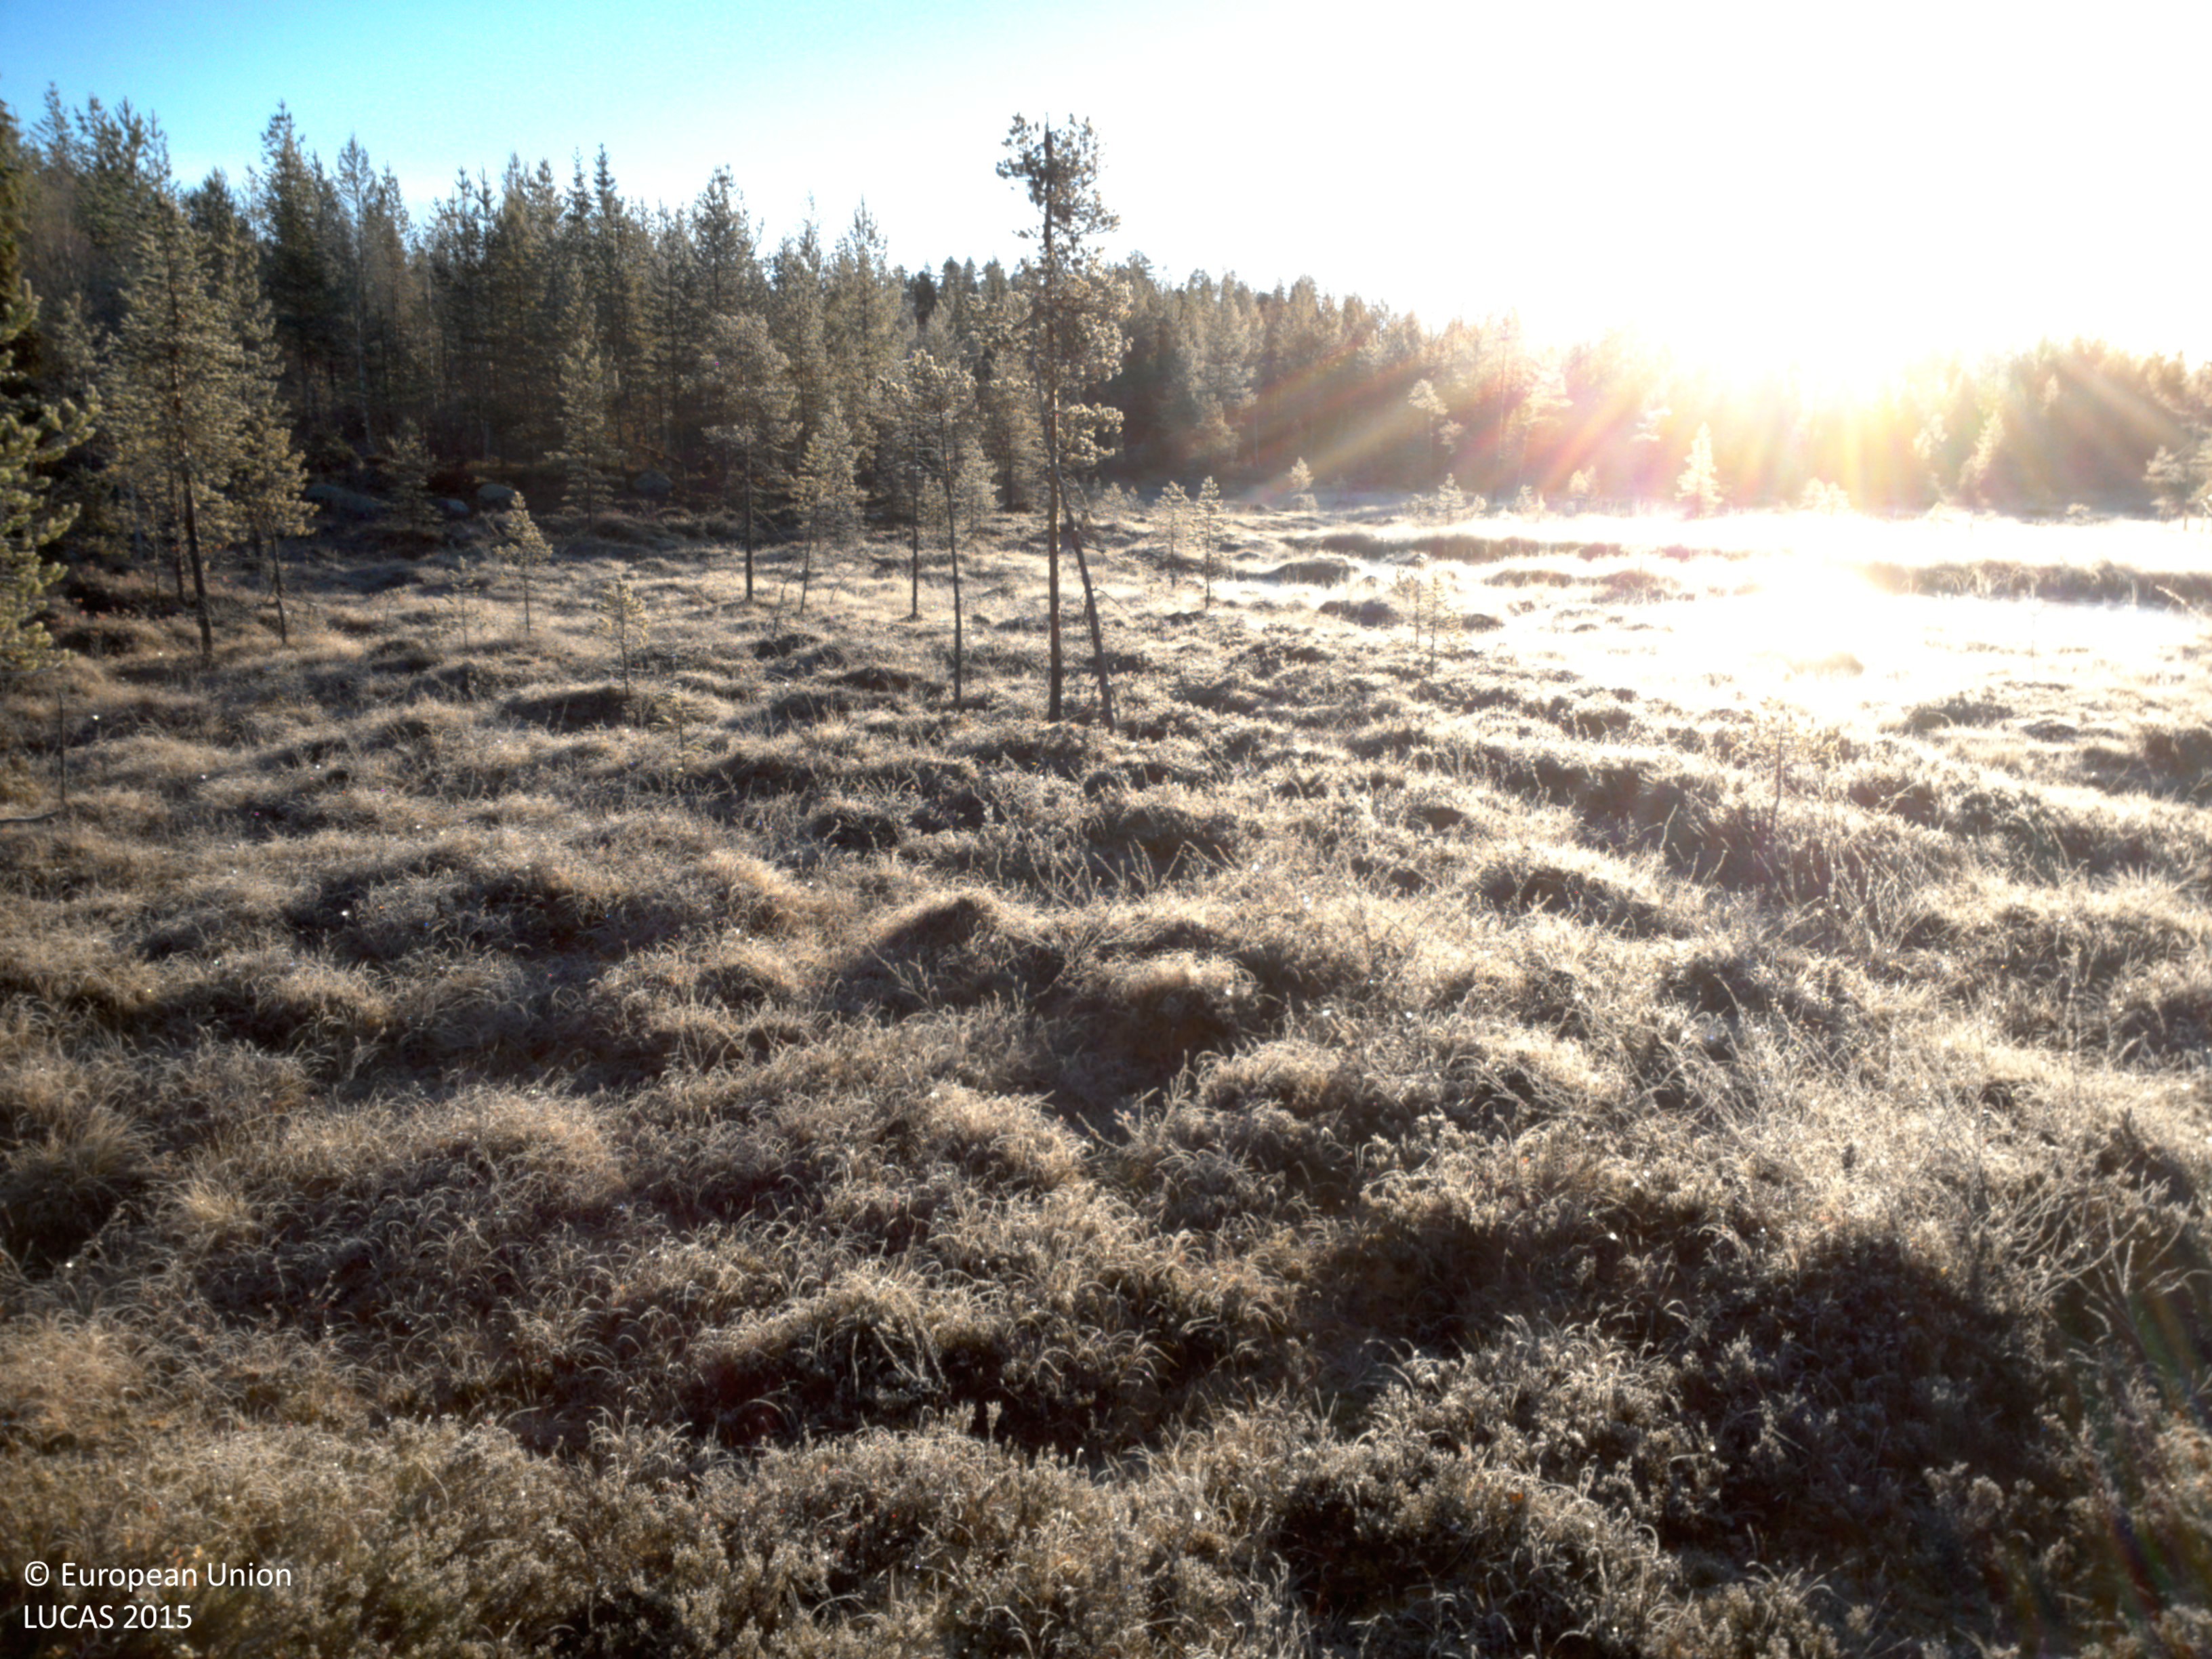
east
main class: Woodland
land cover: Pine dominated coniferous woodland
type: mire and swamp forests
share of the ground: 25 - 50 %
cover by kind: coniferous forest trees 50 %, shrubs 25 %, herbaceous plants 15 %, lichens and mosses 10 %
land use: Forestry
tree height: > 5 m
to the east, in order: Pine dominated coniferous woodland; Peatbogs; Pine dominated coniferous woodland; Pine dominated mixed woodland; Spruce dominated mixed woodland; Pine dominated mixed woodland; Spruce dominated mixed woodland; Broadleaved woodland; Other mixed woodland; Broadleaved woodland
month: October
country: SE
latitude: 64.7131
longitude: 17.8340
